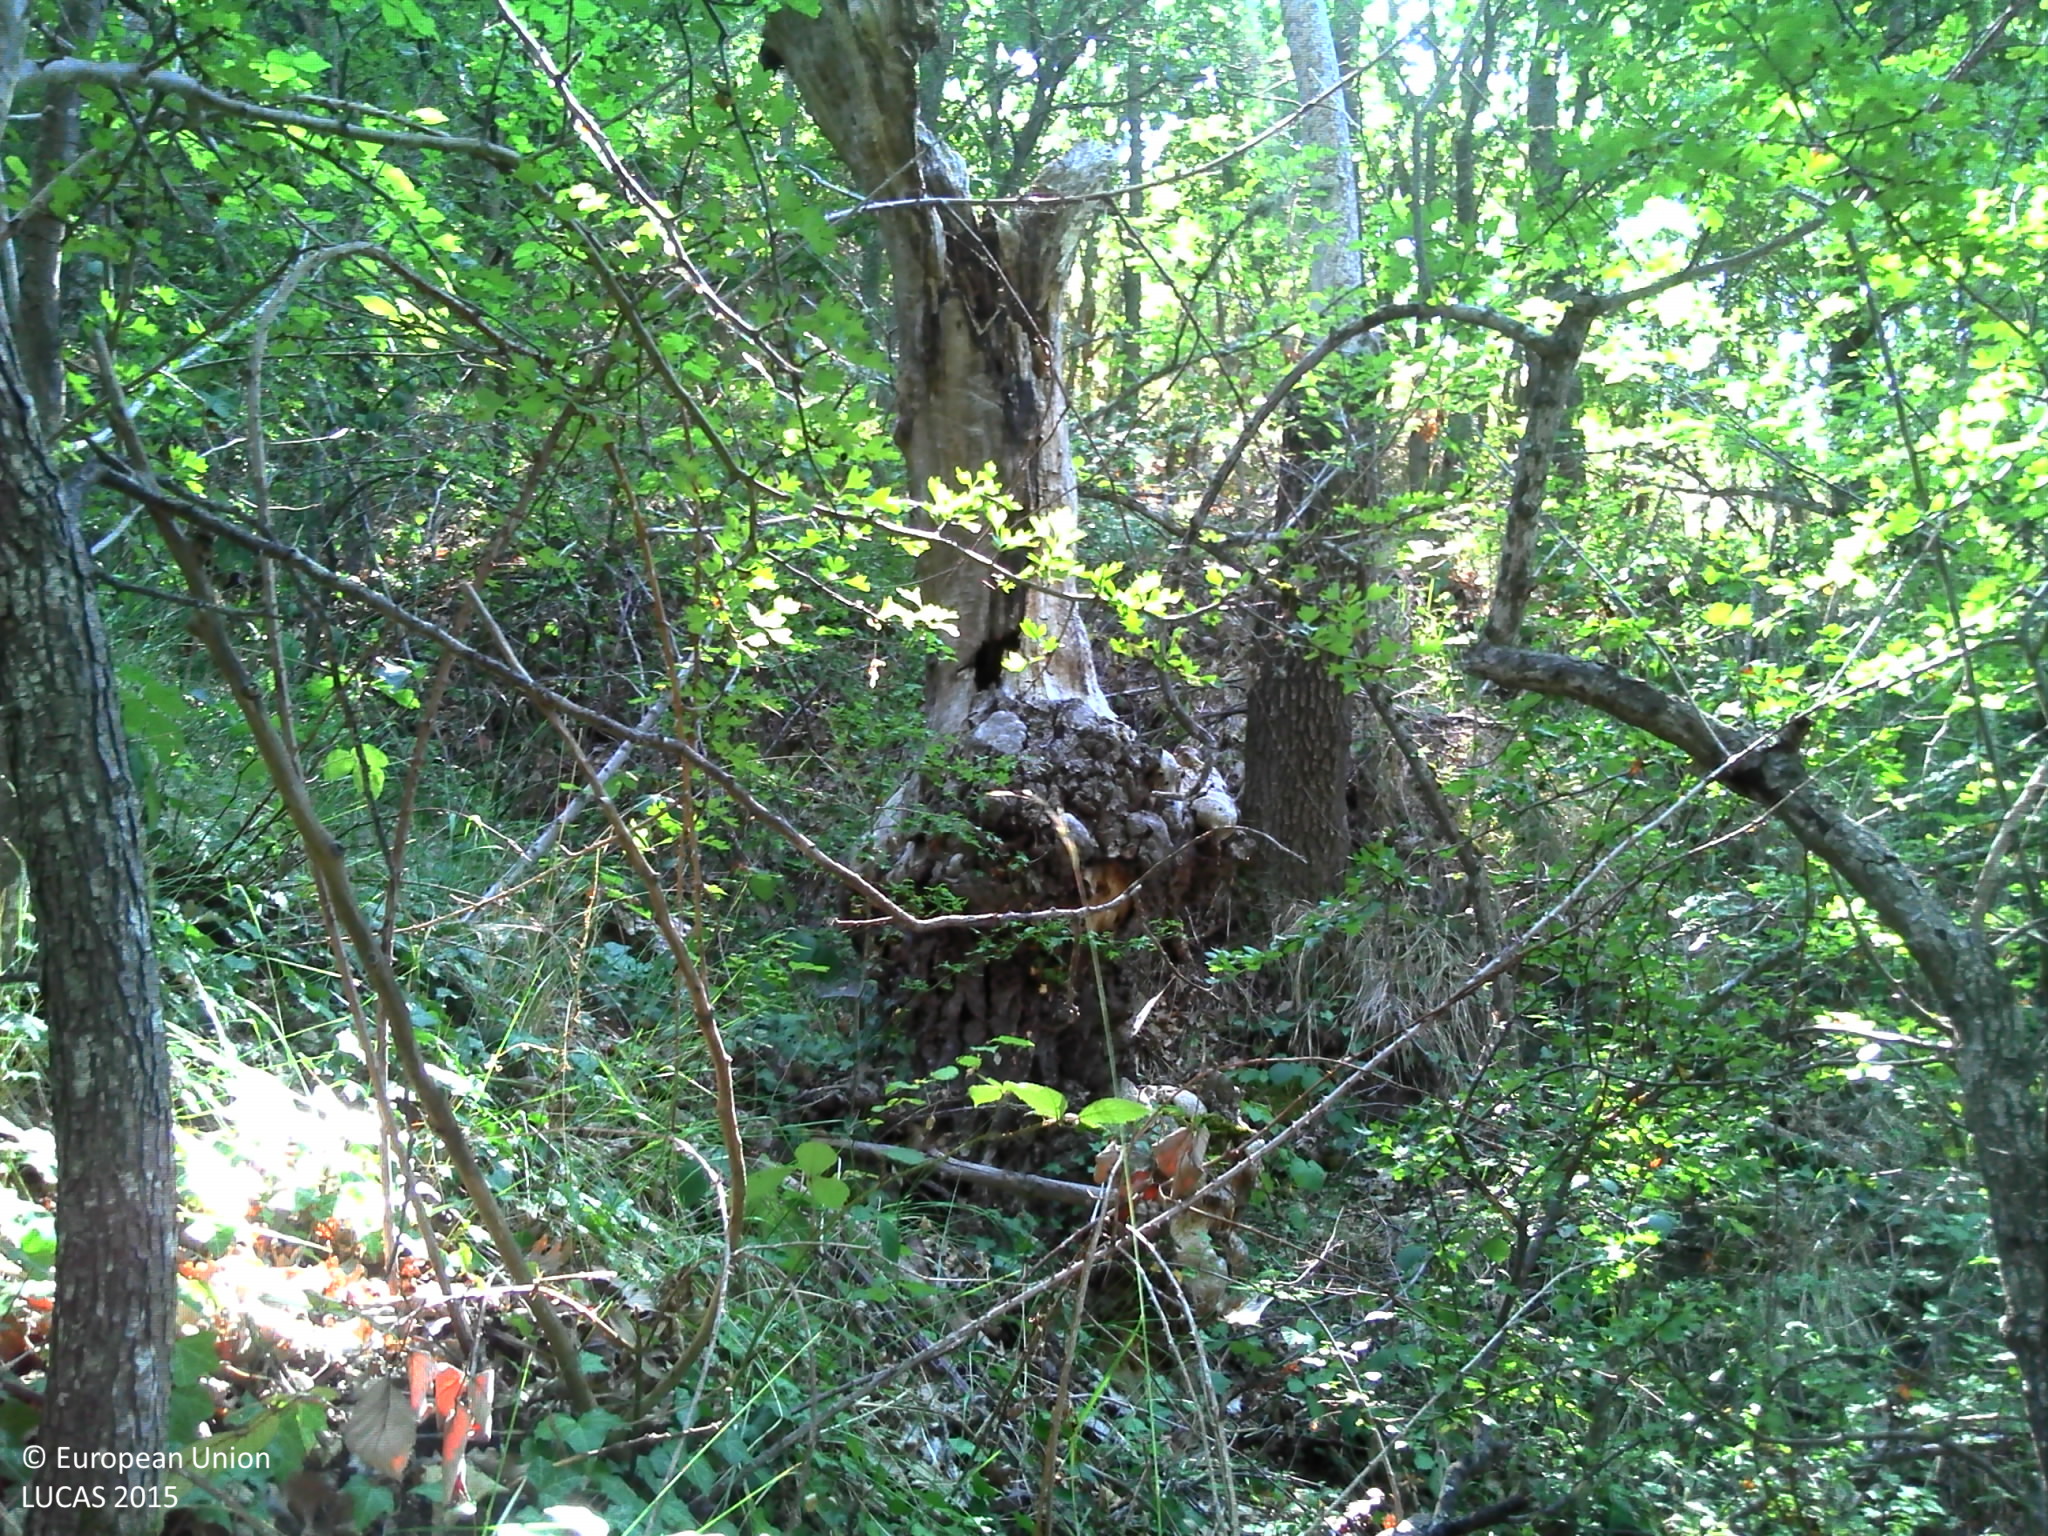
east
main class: Woodland
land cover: Broadleaved woodland
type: acidophilous oak and oak-birch forest
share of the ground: 50 - 75 %
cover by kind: broadleaved forest trees 60 %, herbaceous plants 30 %, unconsolidated bare surface 10 %
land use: Forestry
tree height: > 5 m
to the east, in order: Broadleaved woodland; Grassland with sparse tree/shrub cover; Abandoned hedges; Grassland with sparse tree/shrub cover; Broadleaved woodland
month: August
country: FR
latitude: 45.6017
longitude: 3.0642
